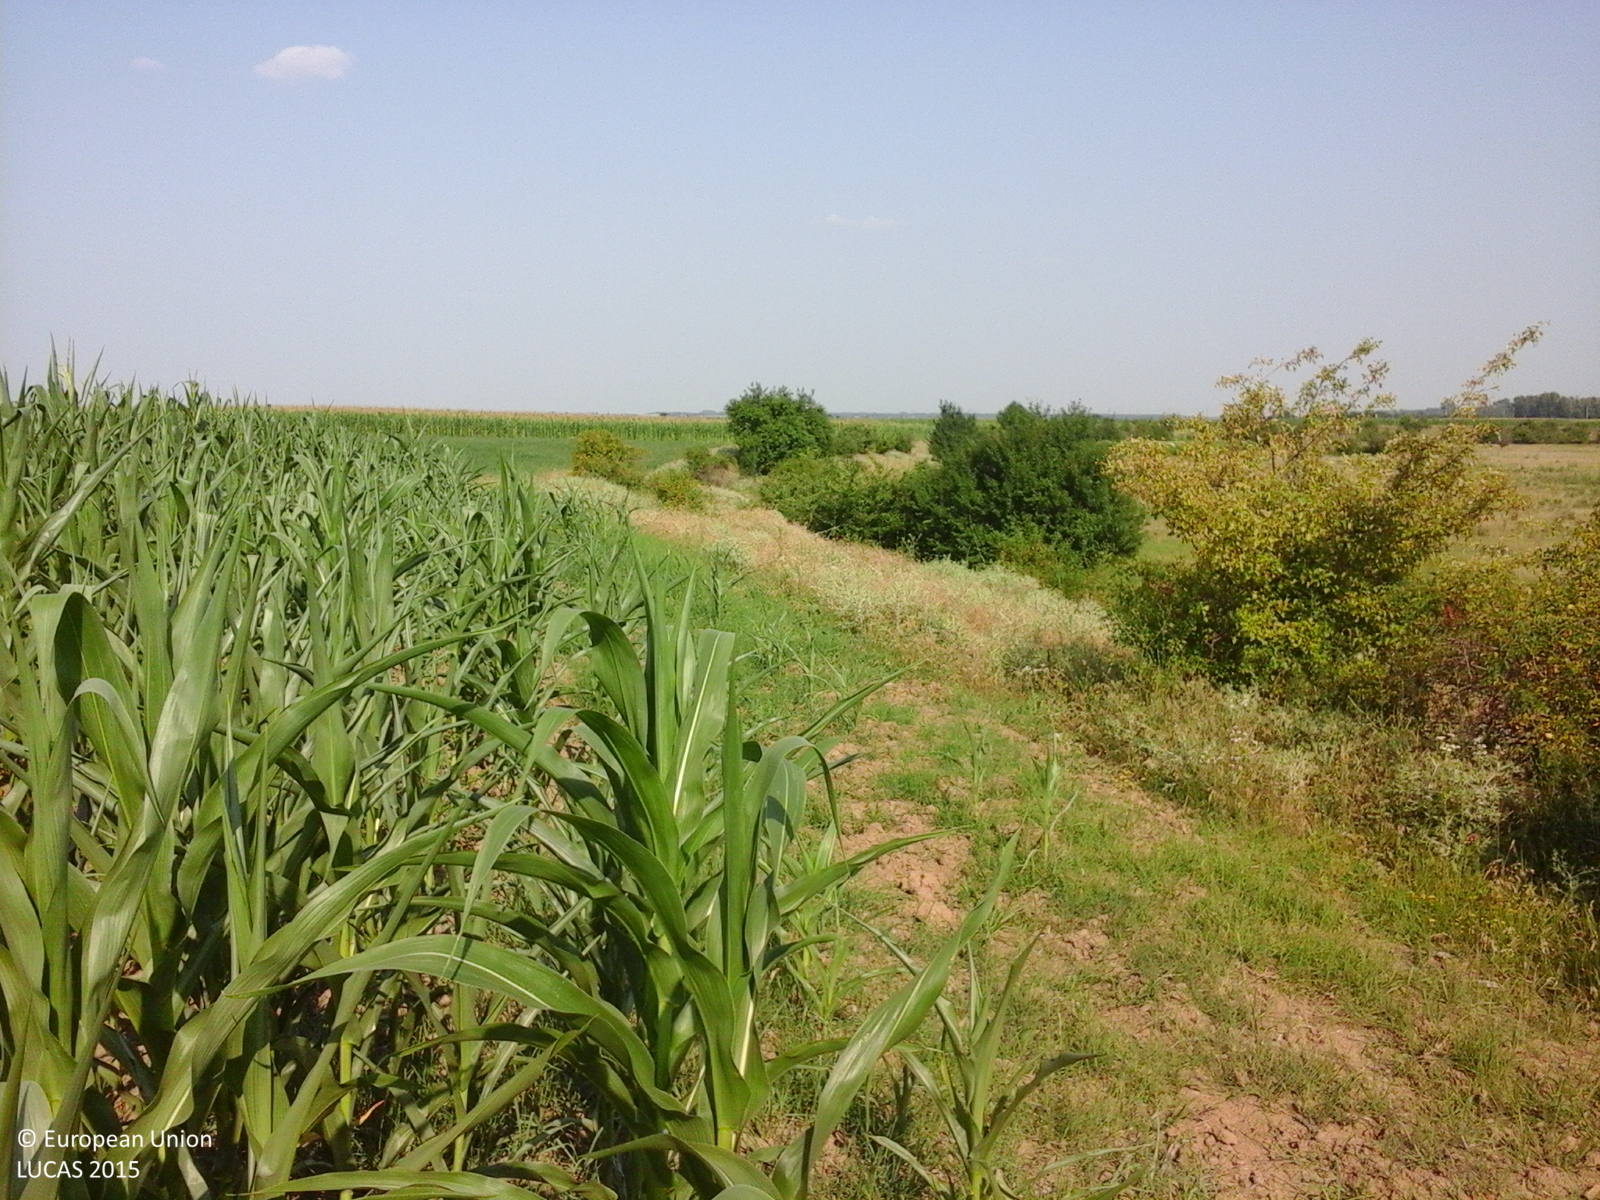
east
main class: Cropland
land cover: Maize
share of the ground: > 75 %
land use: Agriculture (excluding fallow land and kitchen gardens)
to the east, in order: Maize; Lucerne; Maize; Lucerne; Maize; Lucerne; Maize
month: July
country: RO
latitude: 44.5434
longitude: 25.5622
